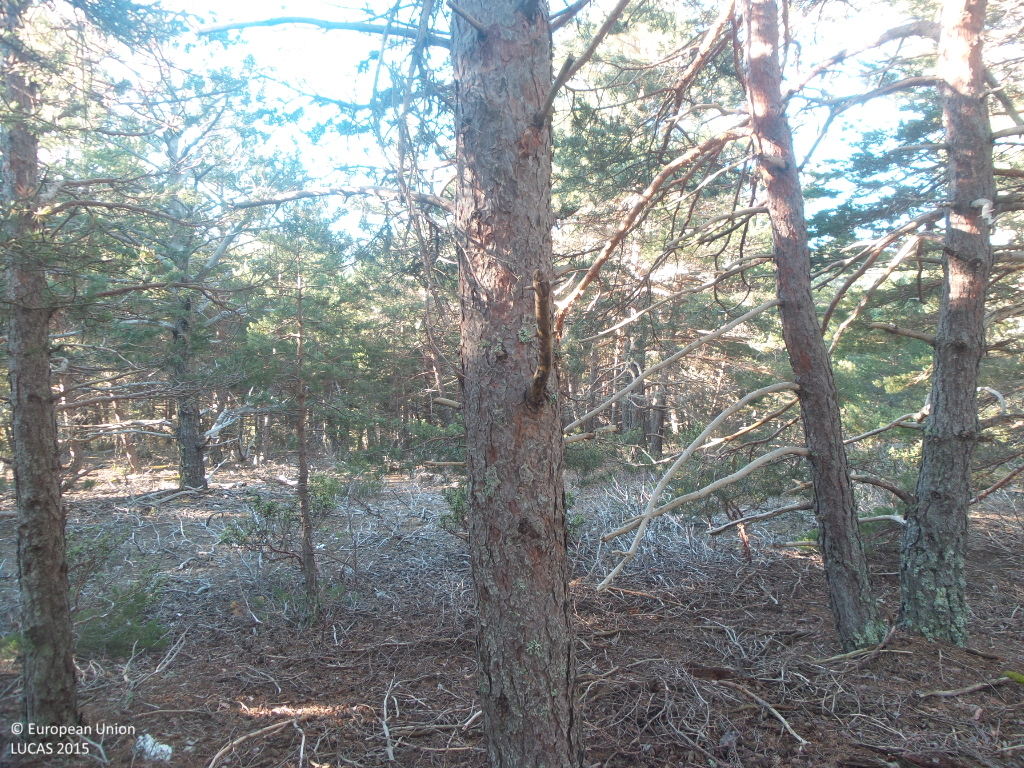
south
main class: Woodland
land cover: Pine dominated coniferous woodland
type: coniferous forest of the mediterranean region
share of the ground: > 75 %
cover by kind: coniferous forest trees 85 %, shrubs 5 %, lichens and mosses 5 %, unconsolidated bare surface 5 %
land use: Forestry
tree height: > 5 m
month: June
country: ES
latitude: 41.1965
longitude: -3.0960
